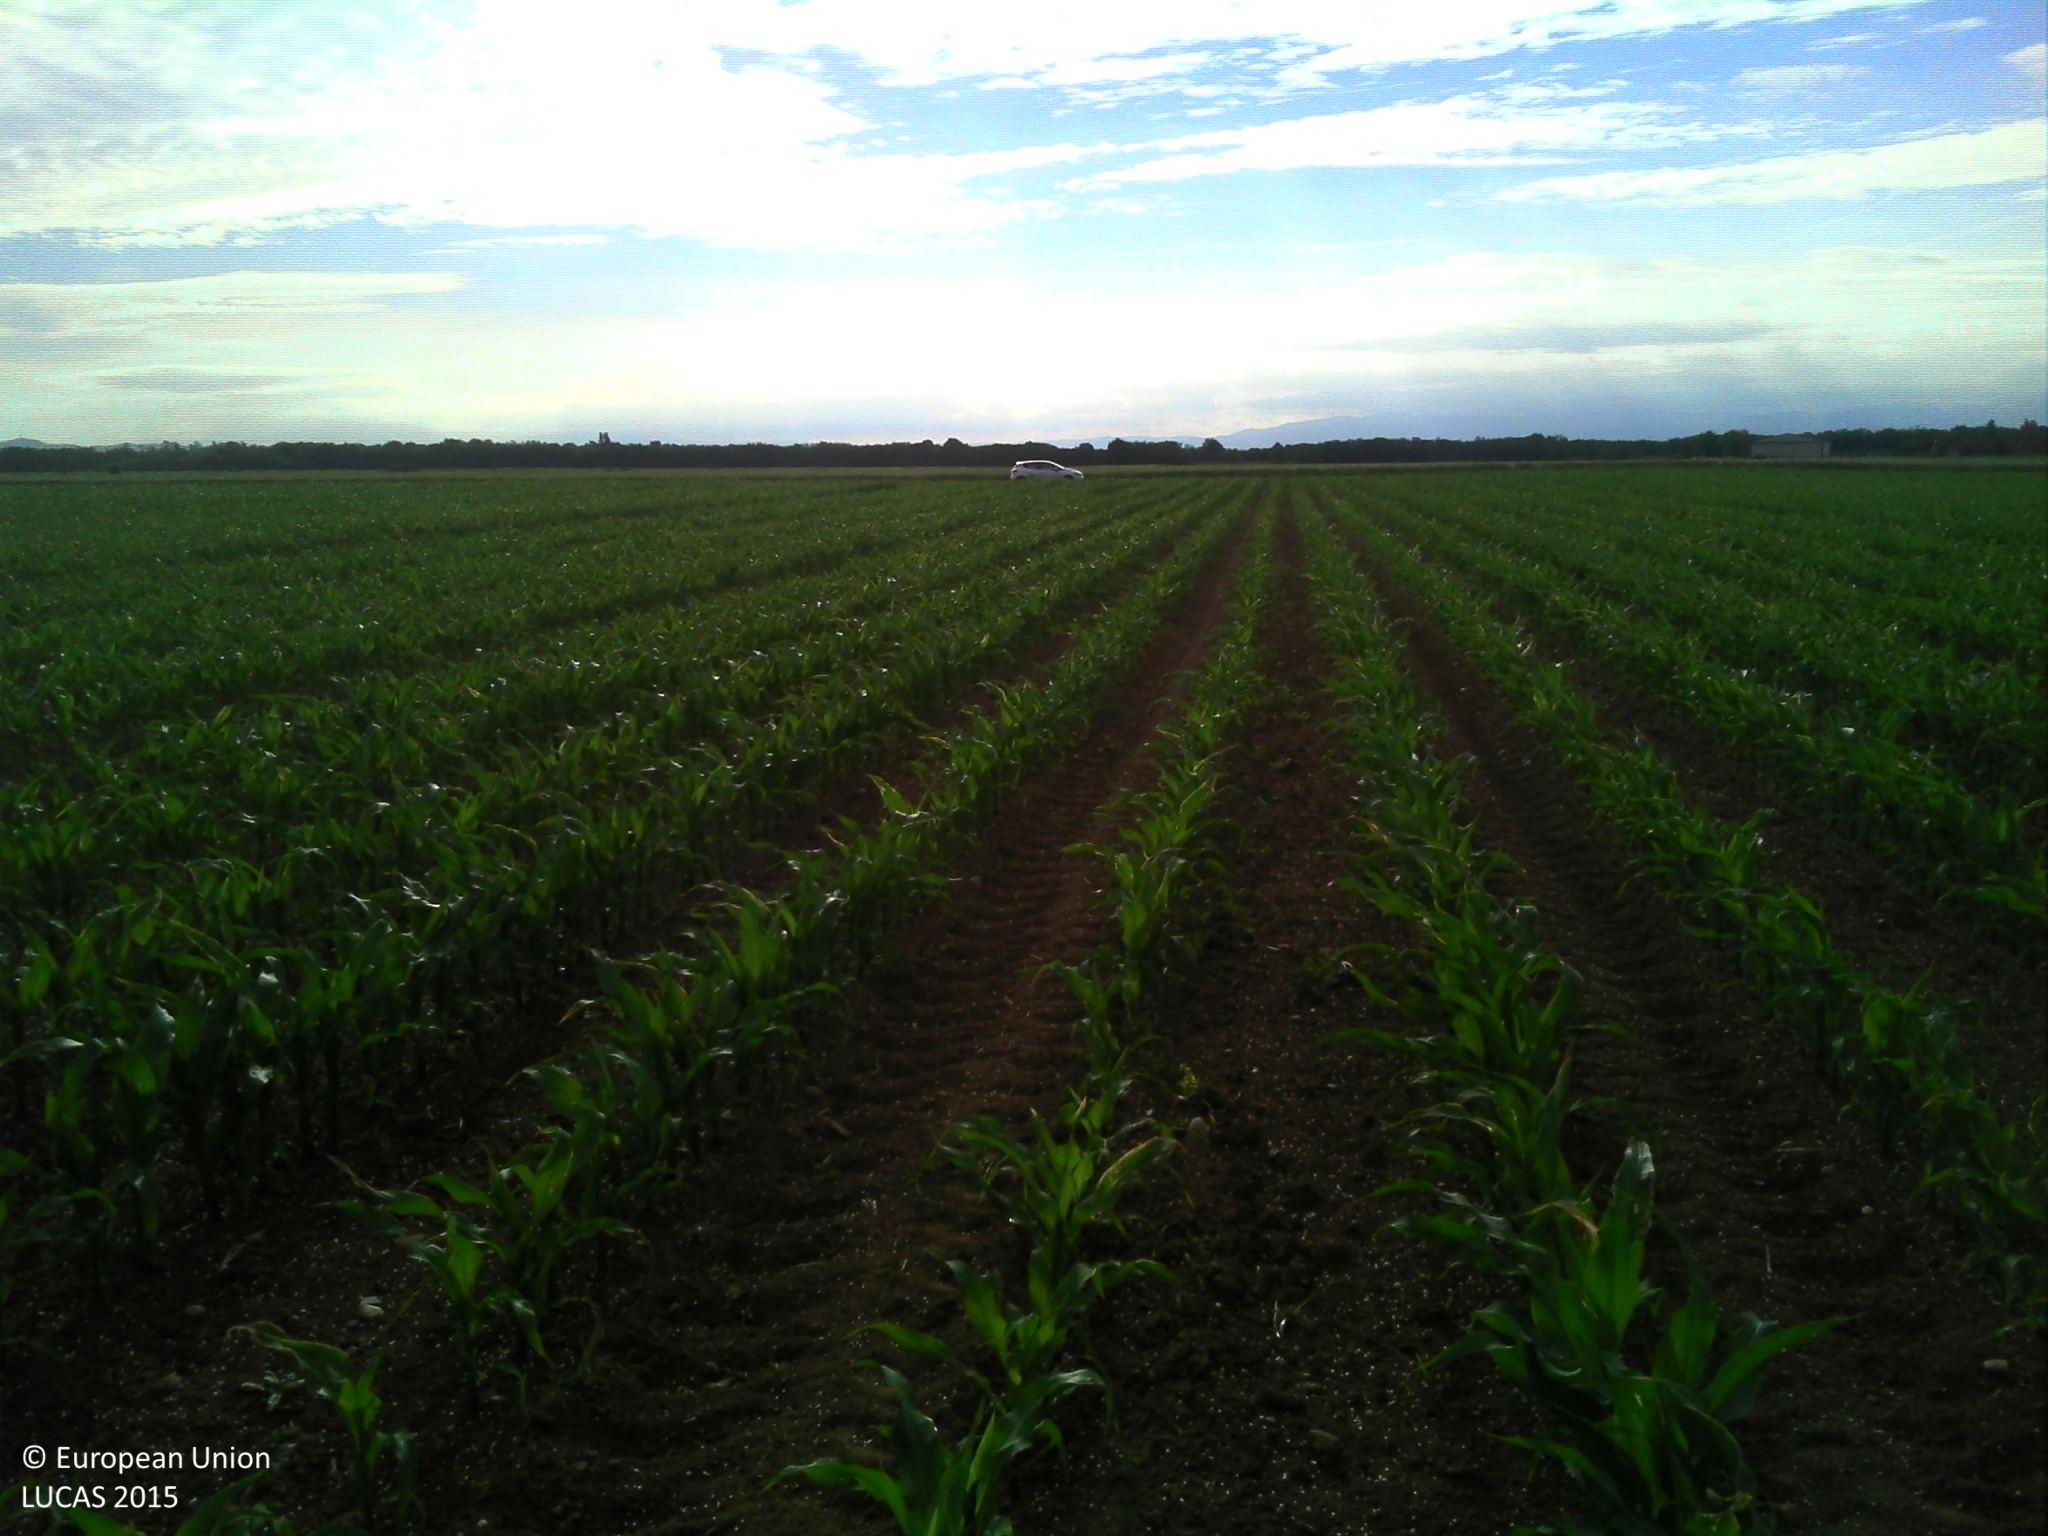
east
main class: Cropland
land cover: Maize
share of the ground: 10 - 25 %
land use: Agriculture (excluding fallow land and kitchen gardens)
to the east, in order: Maize; Grass margins; Paved roads, cycling and walking lanes; Grass margins; Common wheat
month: June
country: FR
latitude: 47.9946
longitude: 7.3880
